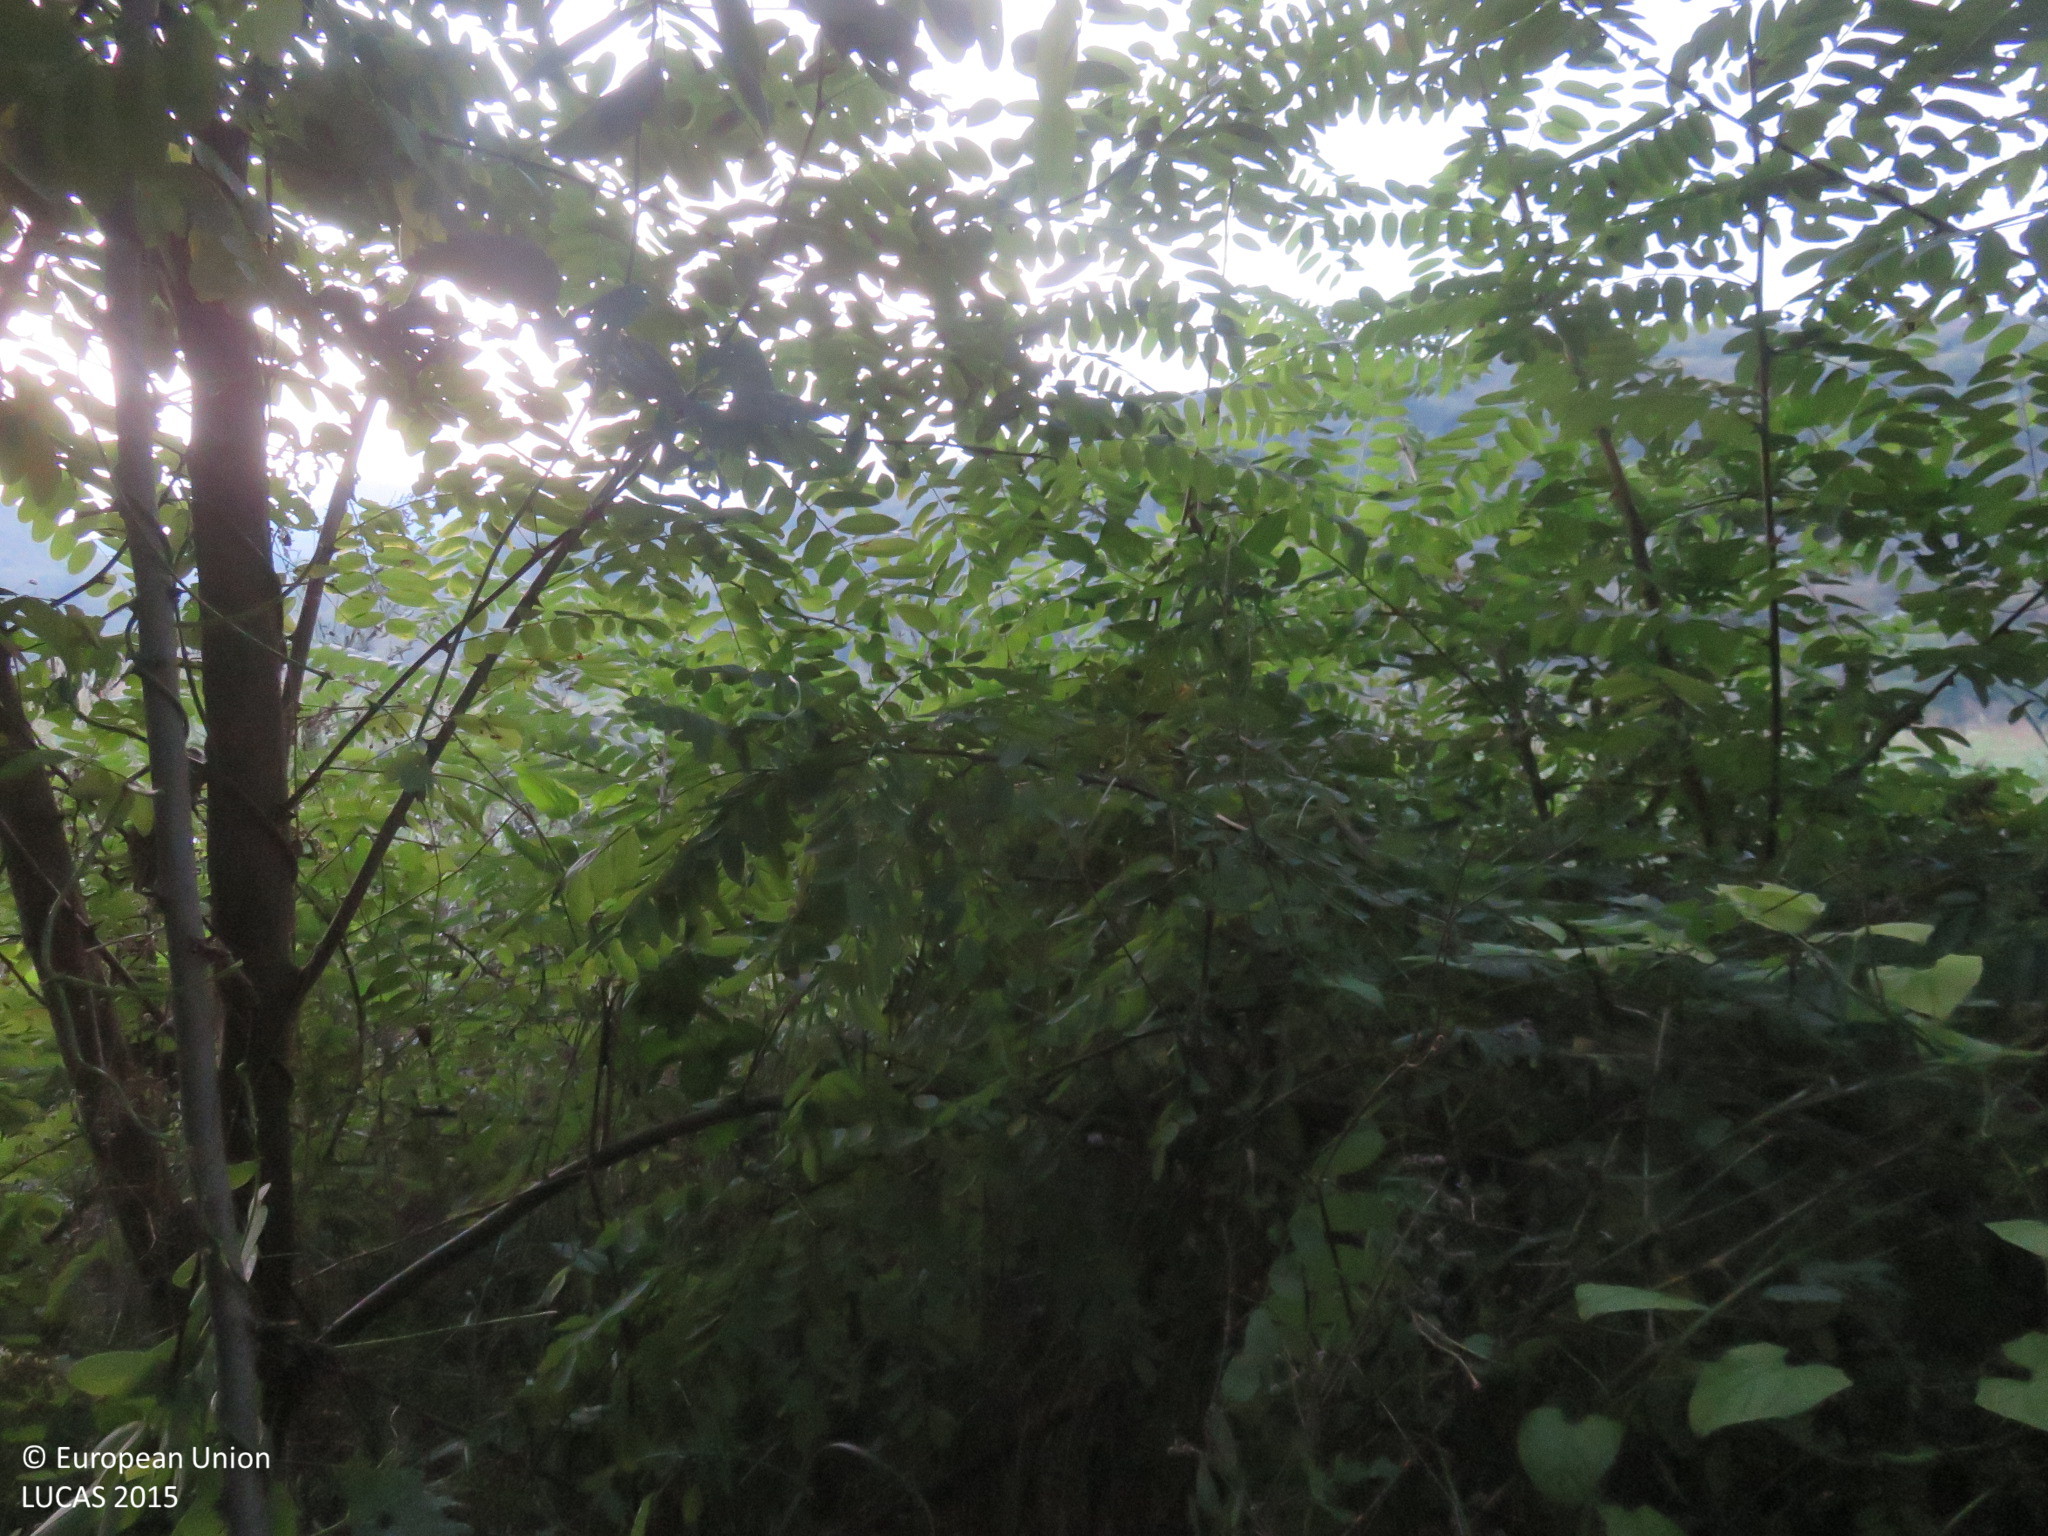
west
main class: Woodland
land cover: Broadleaved woodland
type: mesophytic deciduous forest
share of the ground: > 75 %
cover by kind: broadleaved forest trees 70 %, shrubs 30 %
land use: Semi-natural and natural areas not in use
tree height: < 5 m
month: October
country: BG
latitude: 43.1520
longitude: 25.1843
